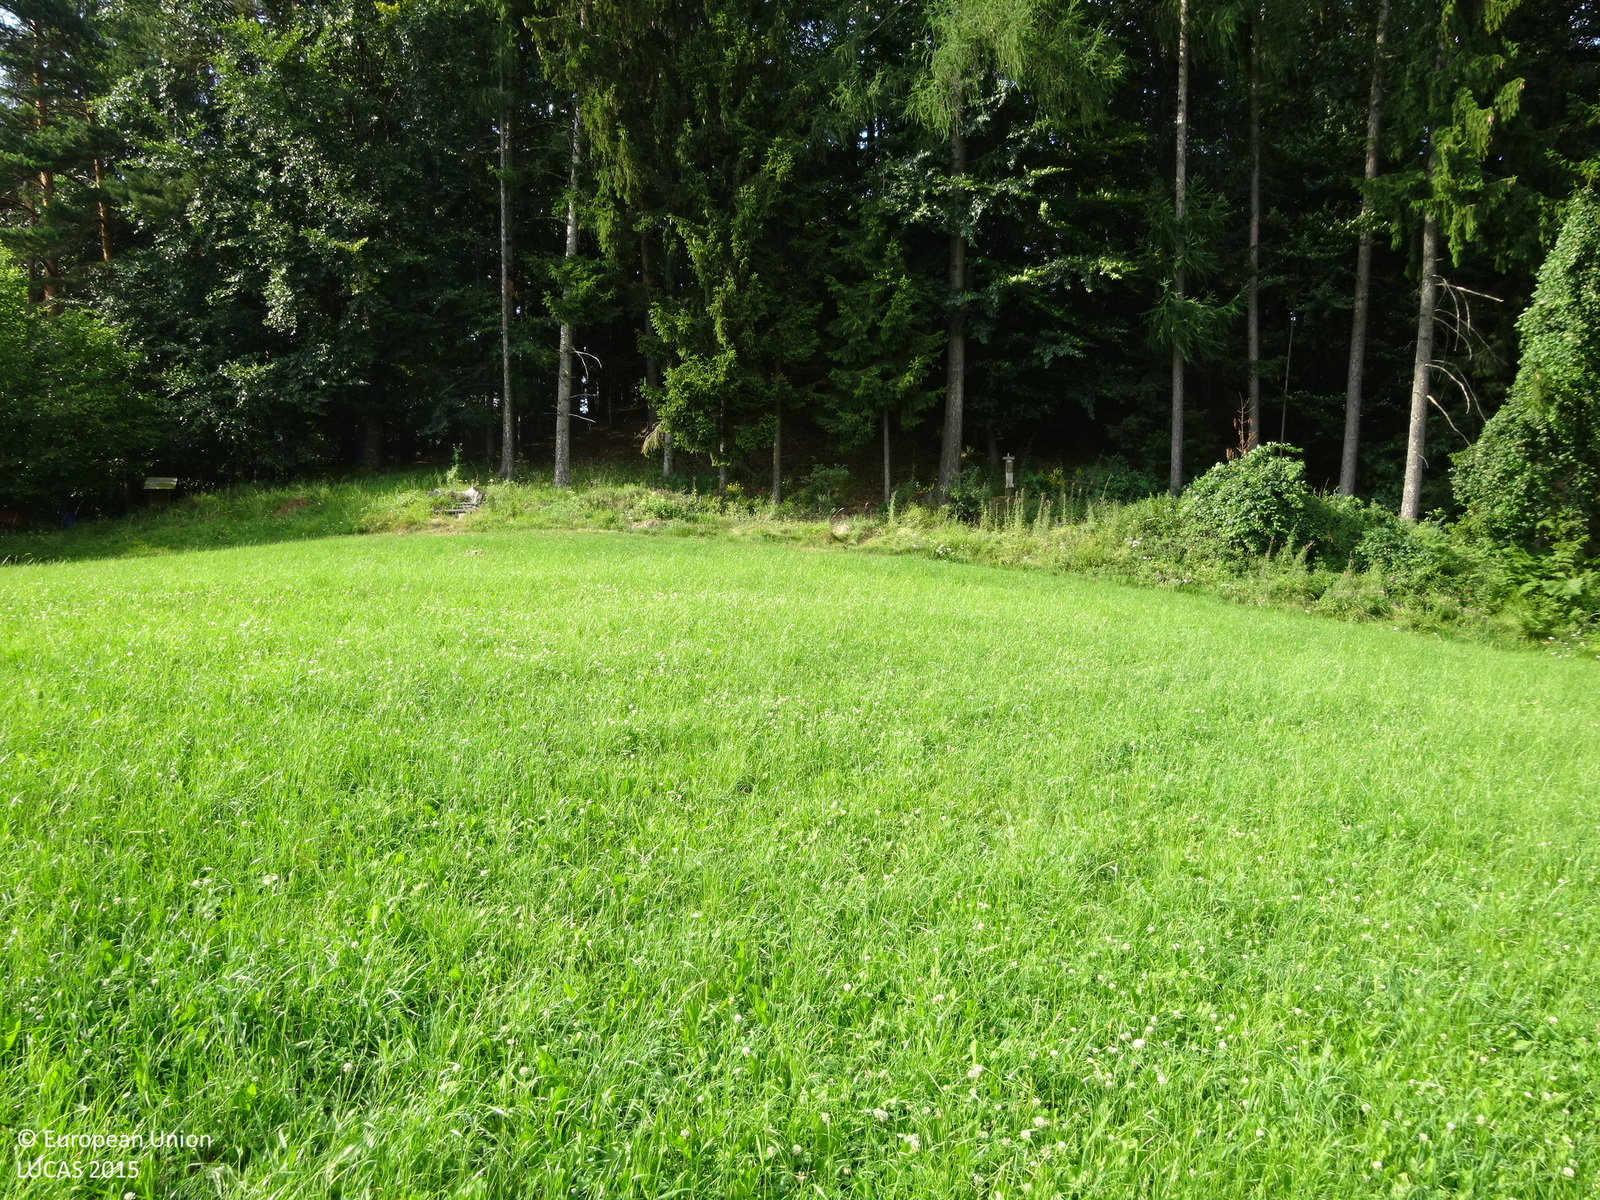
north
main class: Grassland
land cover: Grassland without tree/shrub cover
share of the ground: > 75 %
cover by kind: herbaceous plants 100 %
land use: Agriculture (excluding fallow land and kitchen gardens)
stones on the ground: < 10 %
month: July
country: AT
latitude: 47.2657
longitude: 15.6708
